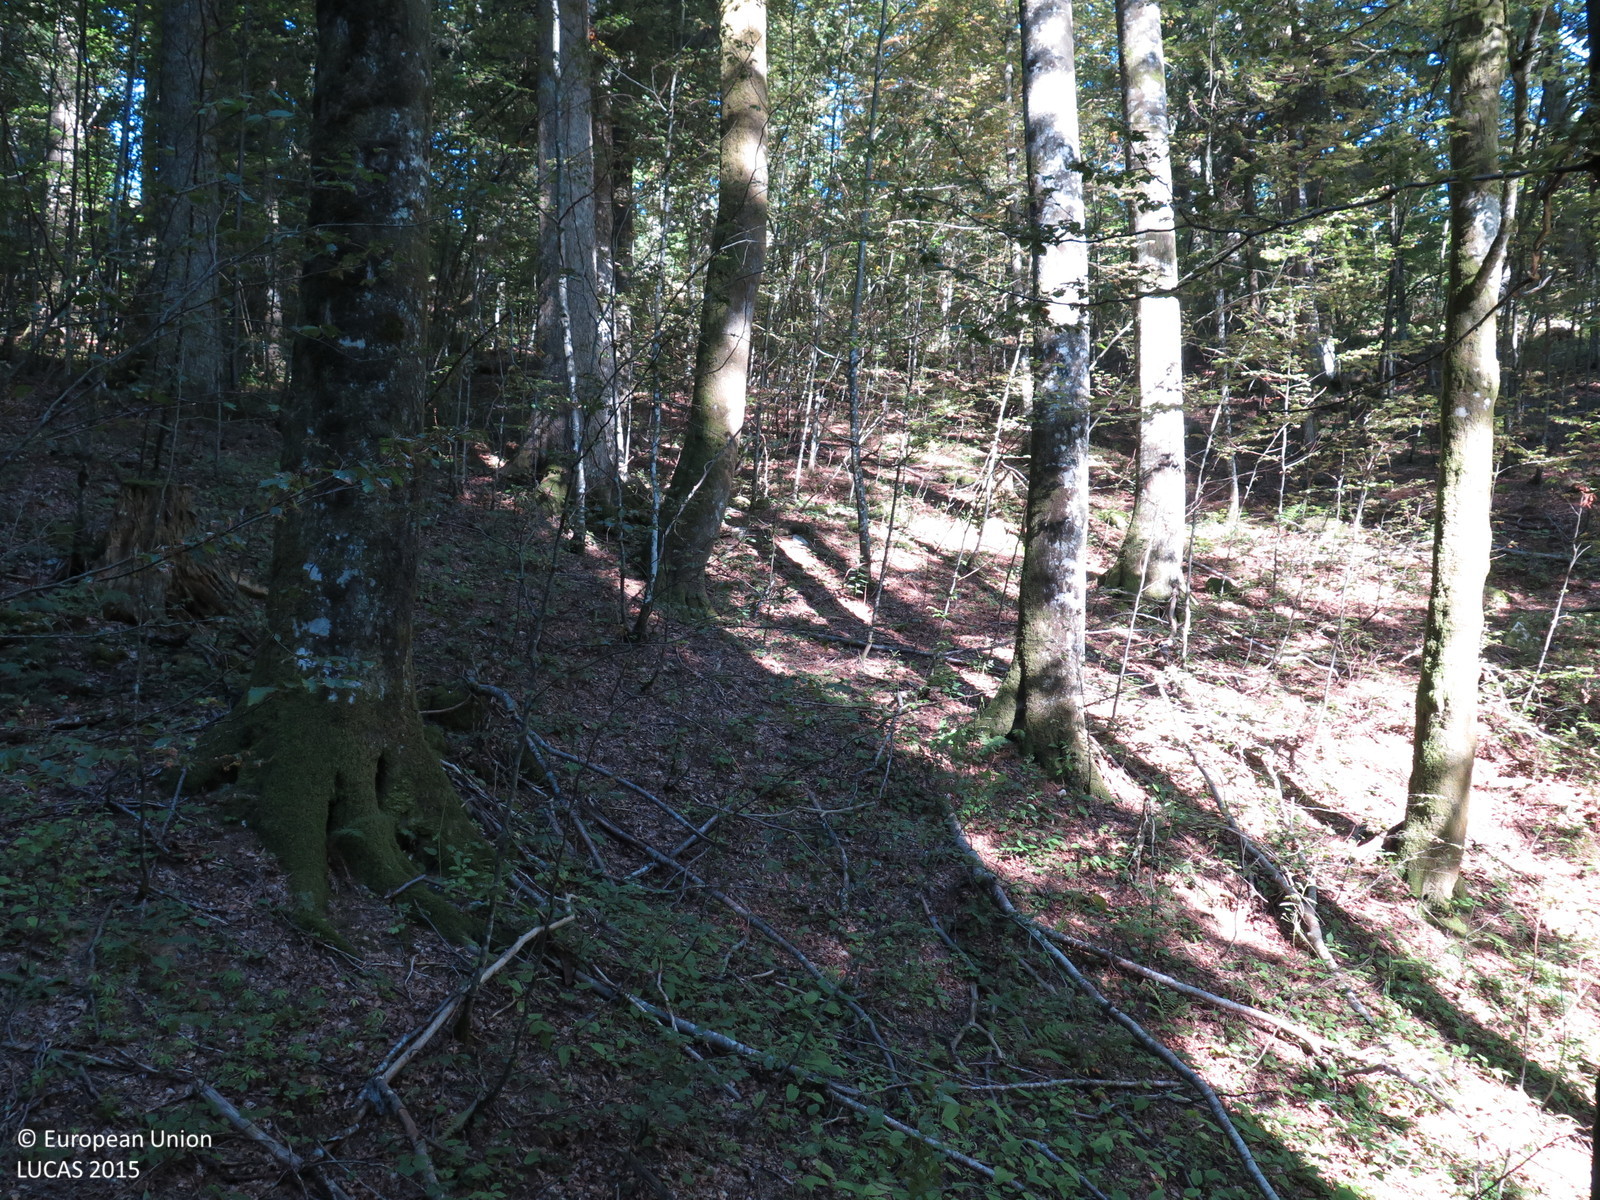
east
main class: Woodland
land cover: Broadleaved woodland
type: mountainous beech forest
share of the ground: > 75 %
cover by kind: broadleaved forest trees 80 %, coniferous forest trees 20 %
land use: Forestry
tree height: > 5 m
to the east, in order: Broadleaved woodland; Groves; Tracks; Groves; Shrubland without tree cover; Other mixed woodland
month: August
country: HR
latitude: 45.3397
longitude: 14.8317
